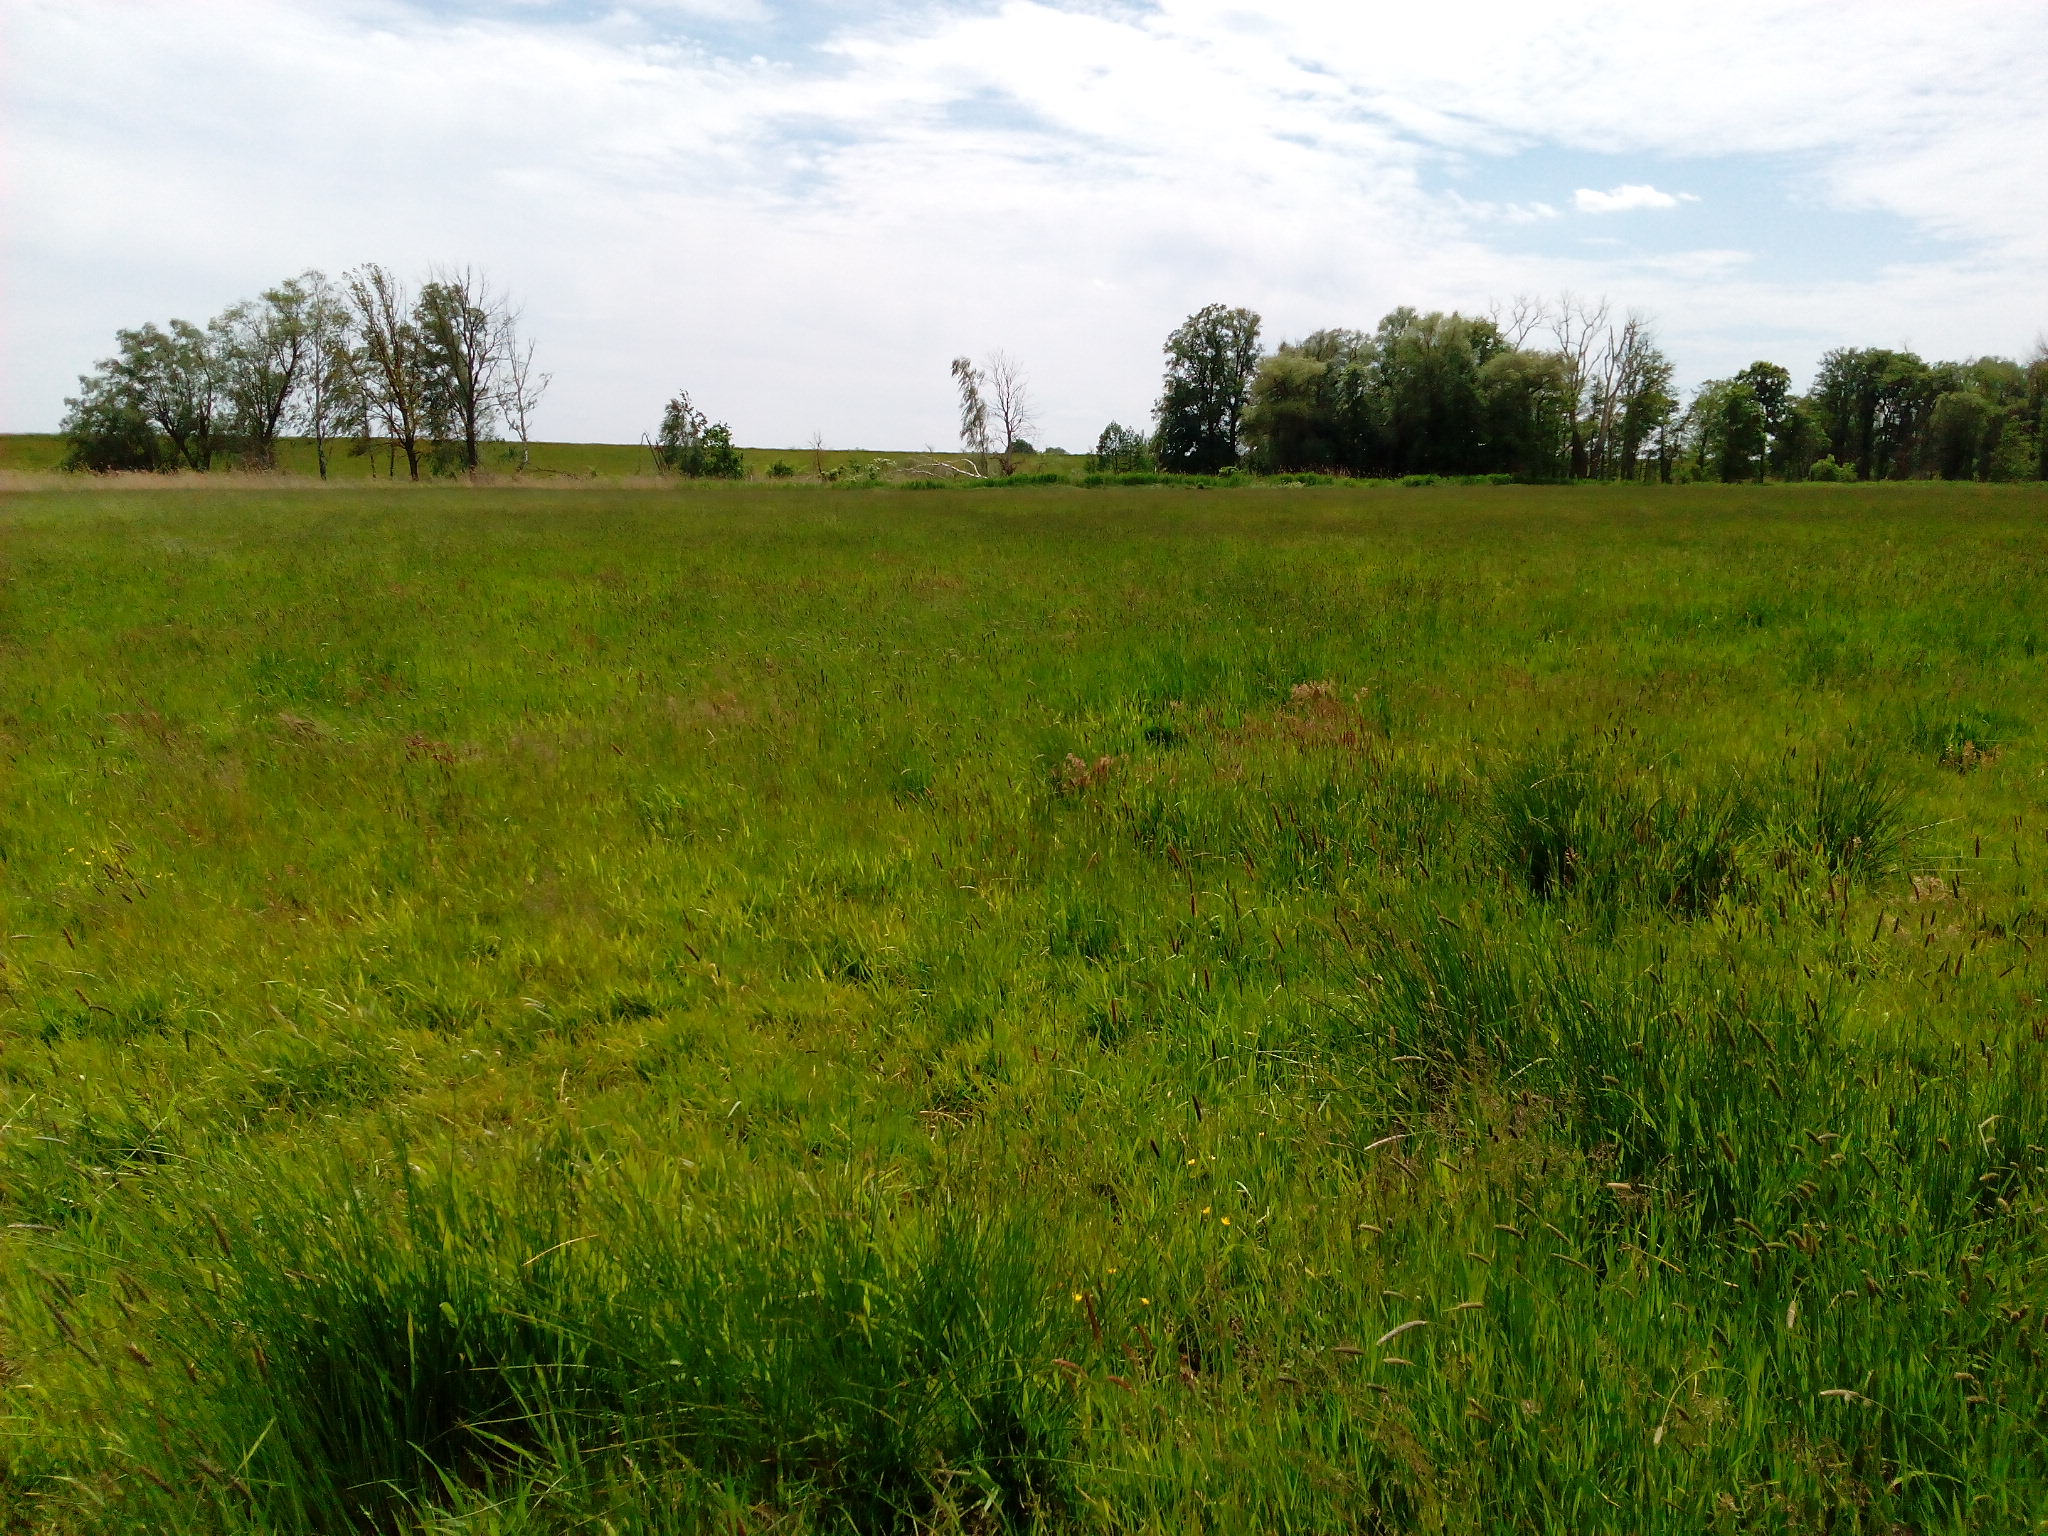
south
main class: Grassland
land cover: Grassland without tree/shrub cover
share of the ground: > 75 %
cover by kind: herbaceous plants 100 %
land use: Agriculture (excluding fallow land and kitchen gardens)
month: June
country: DE
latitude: 52.9707
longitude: 14.1553
